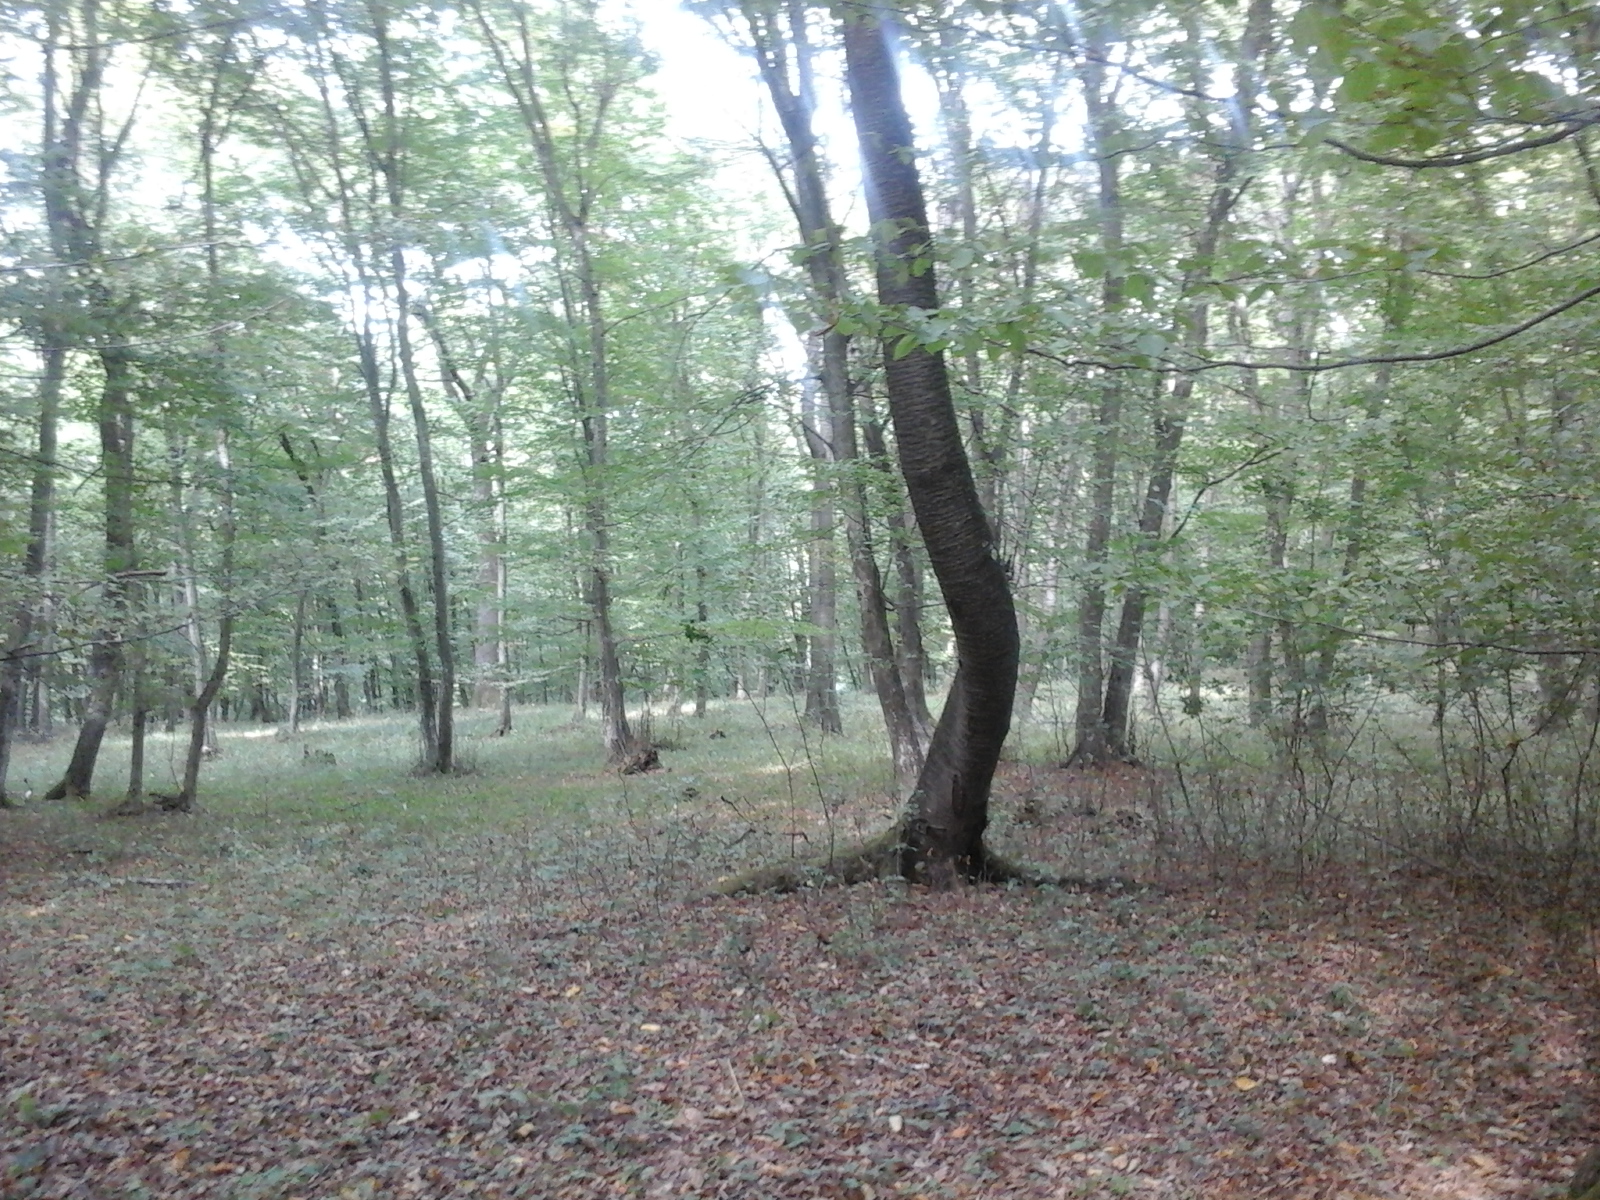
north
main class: Woodland
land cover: Broadleaved woodland
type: mesophytic deciduous forest
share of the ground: > 75 %
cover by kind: broadleaved forest trees 100 %
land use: Forestry
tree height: > 5 m
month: September
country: RO
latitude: 46.9286
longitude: 24.0952
